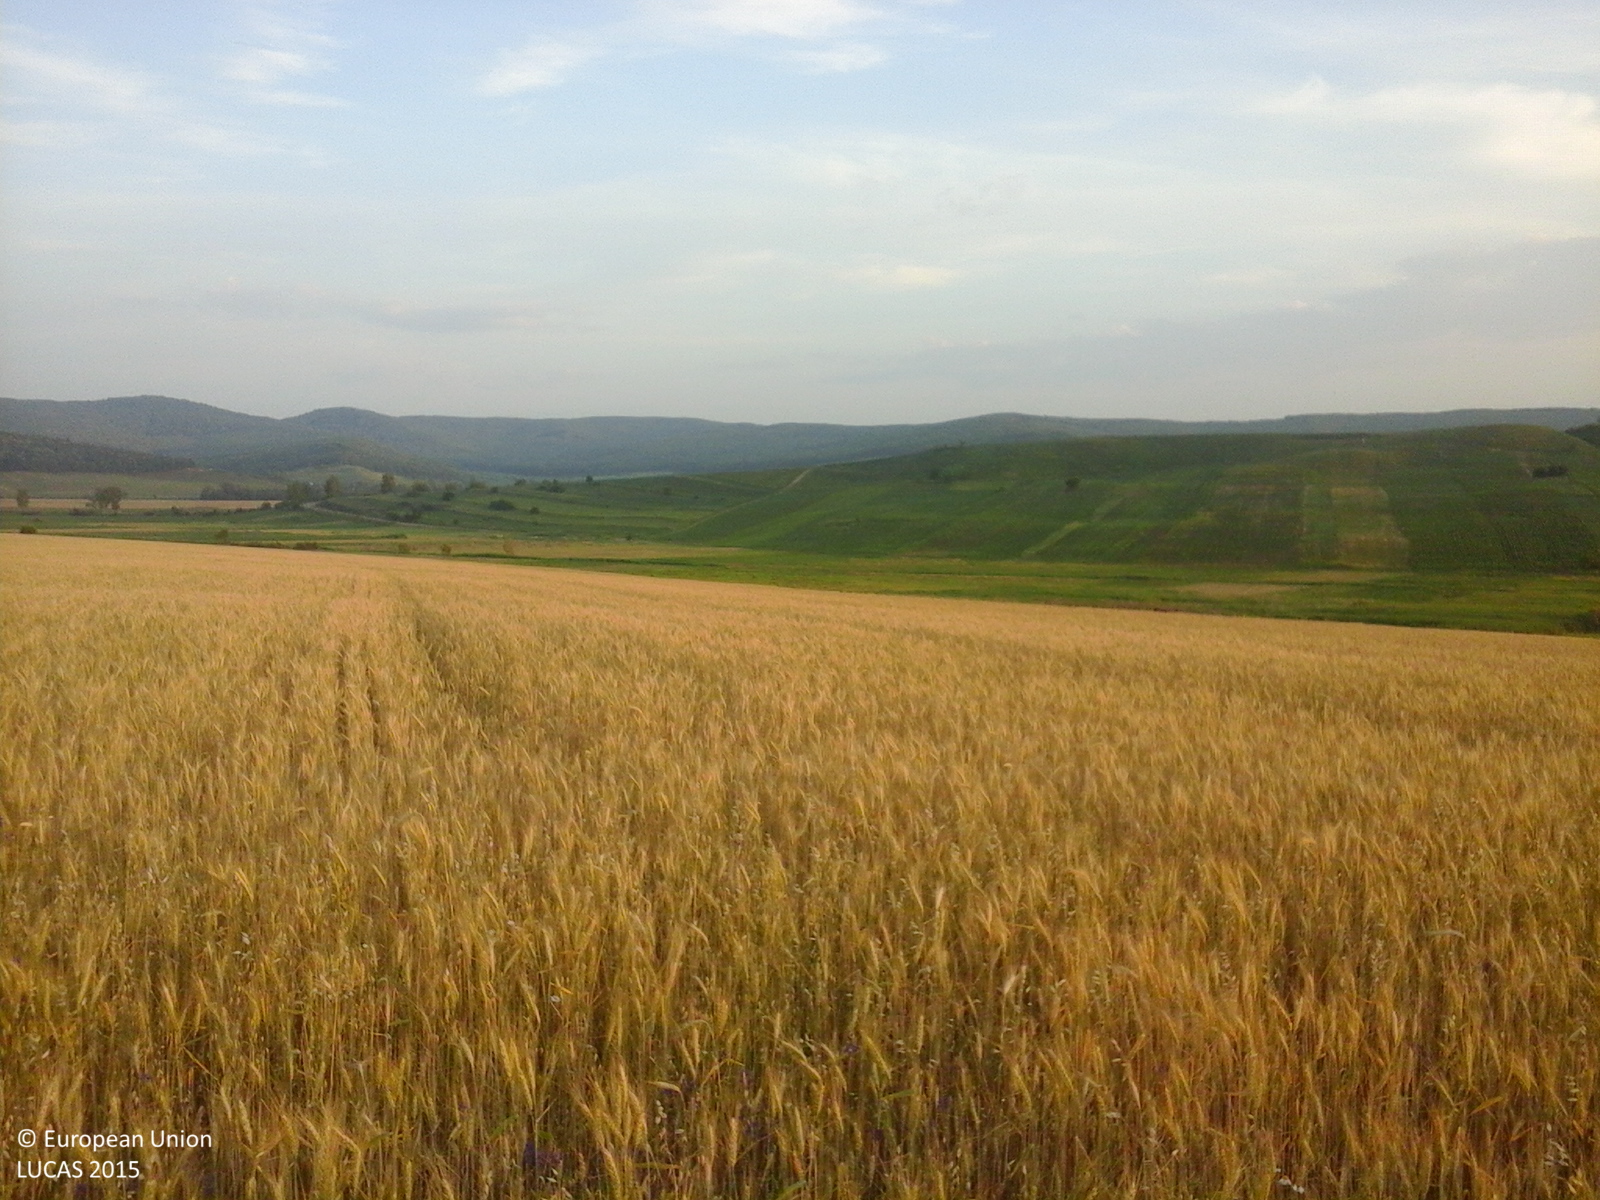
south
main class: Cropland
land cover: Soya
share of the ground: 50 - 75 %
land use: Agriculture (excluding fallow land and kitchen gardens)
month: June
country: RO
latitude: 46.8553
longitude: 27.3294
